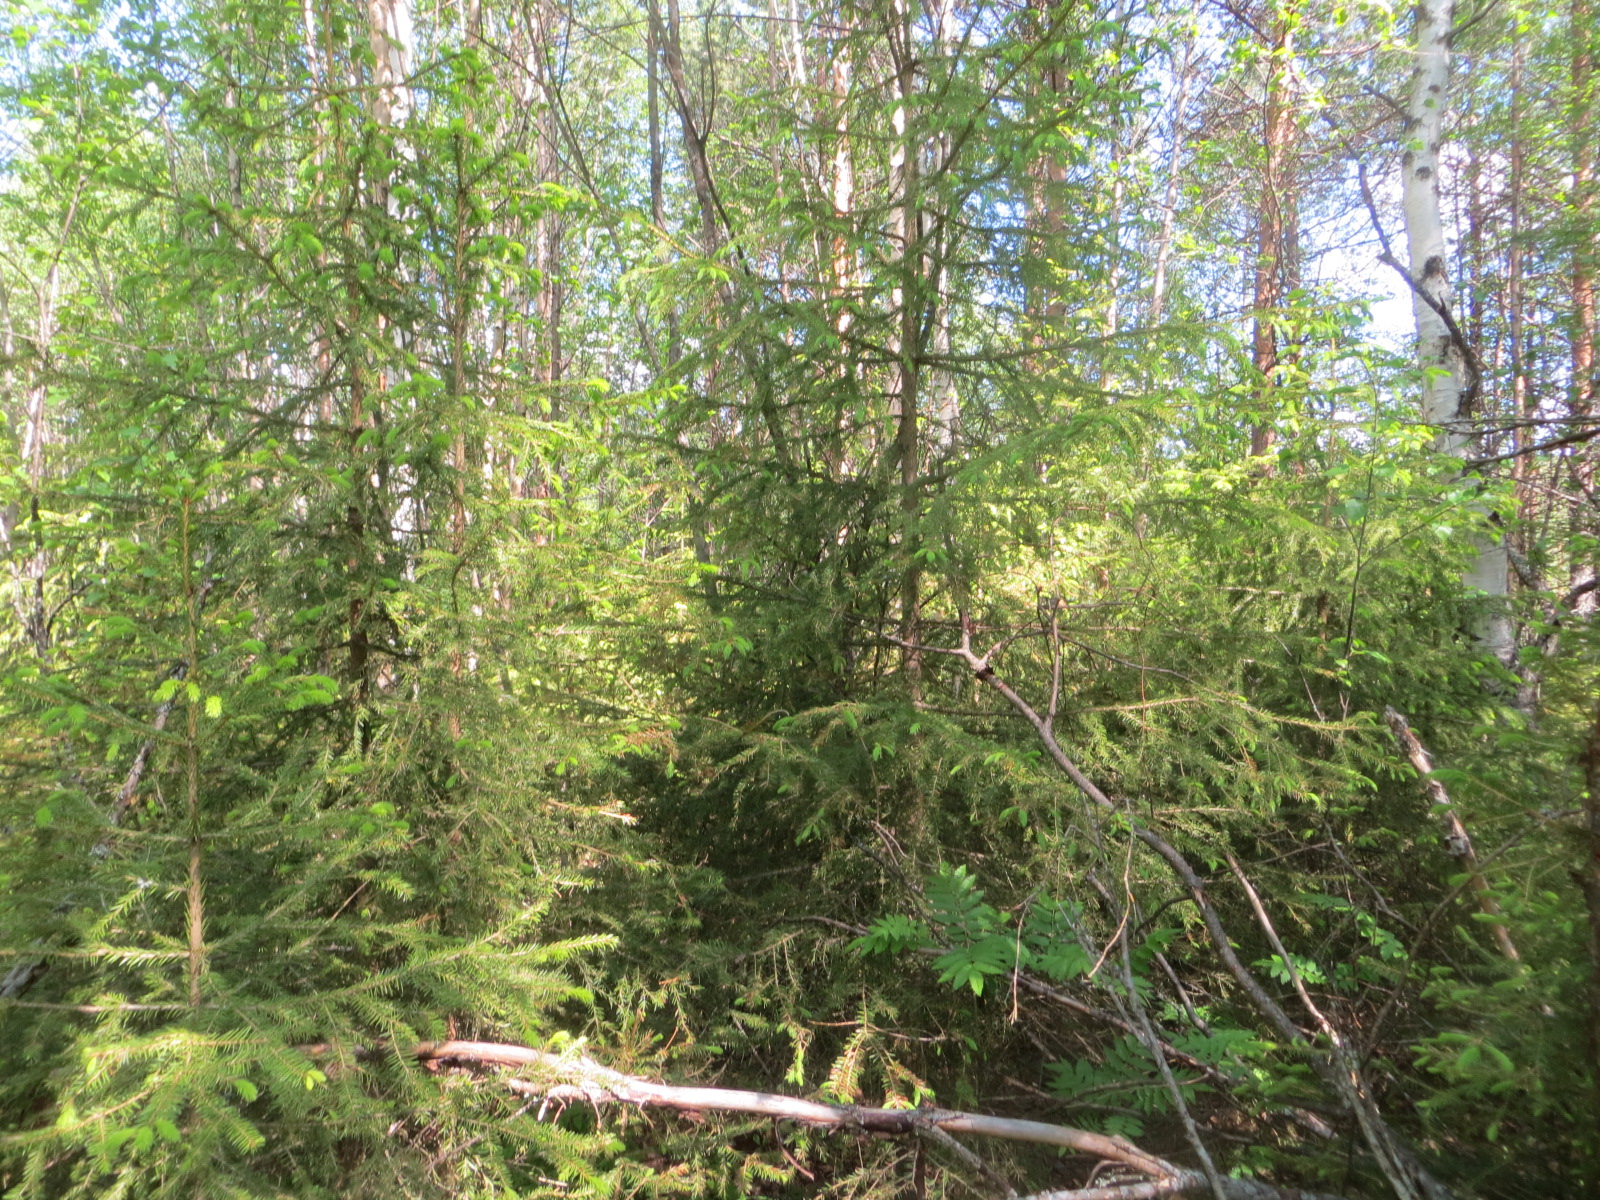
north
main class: Woodland
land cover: Other mixed woodland
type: boreal forest
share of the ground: > 75 %
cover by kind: broadleaved forest trees 45 %, coniferous forest trees 40 %, herbaceous plants 15 %
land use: Forestry
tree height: > 5 m
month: June
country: FI
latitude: 66.5043
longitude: 25.6441
